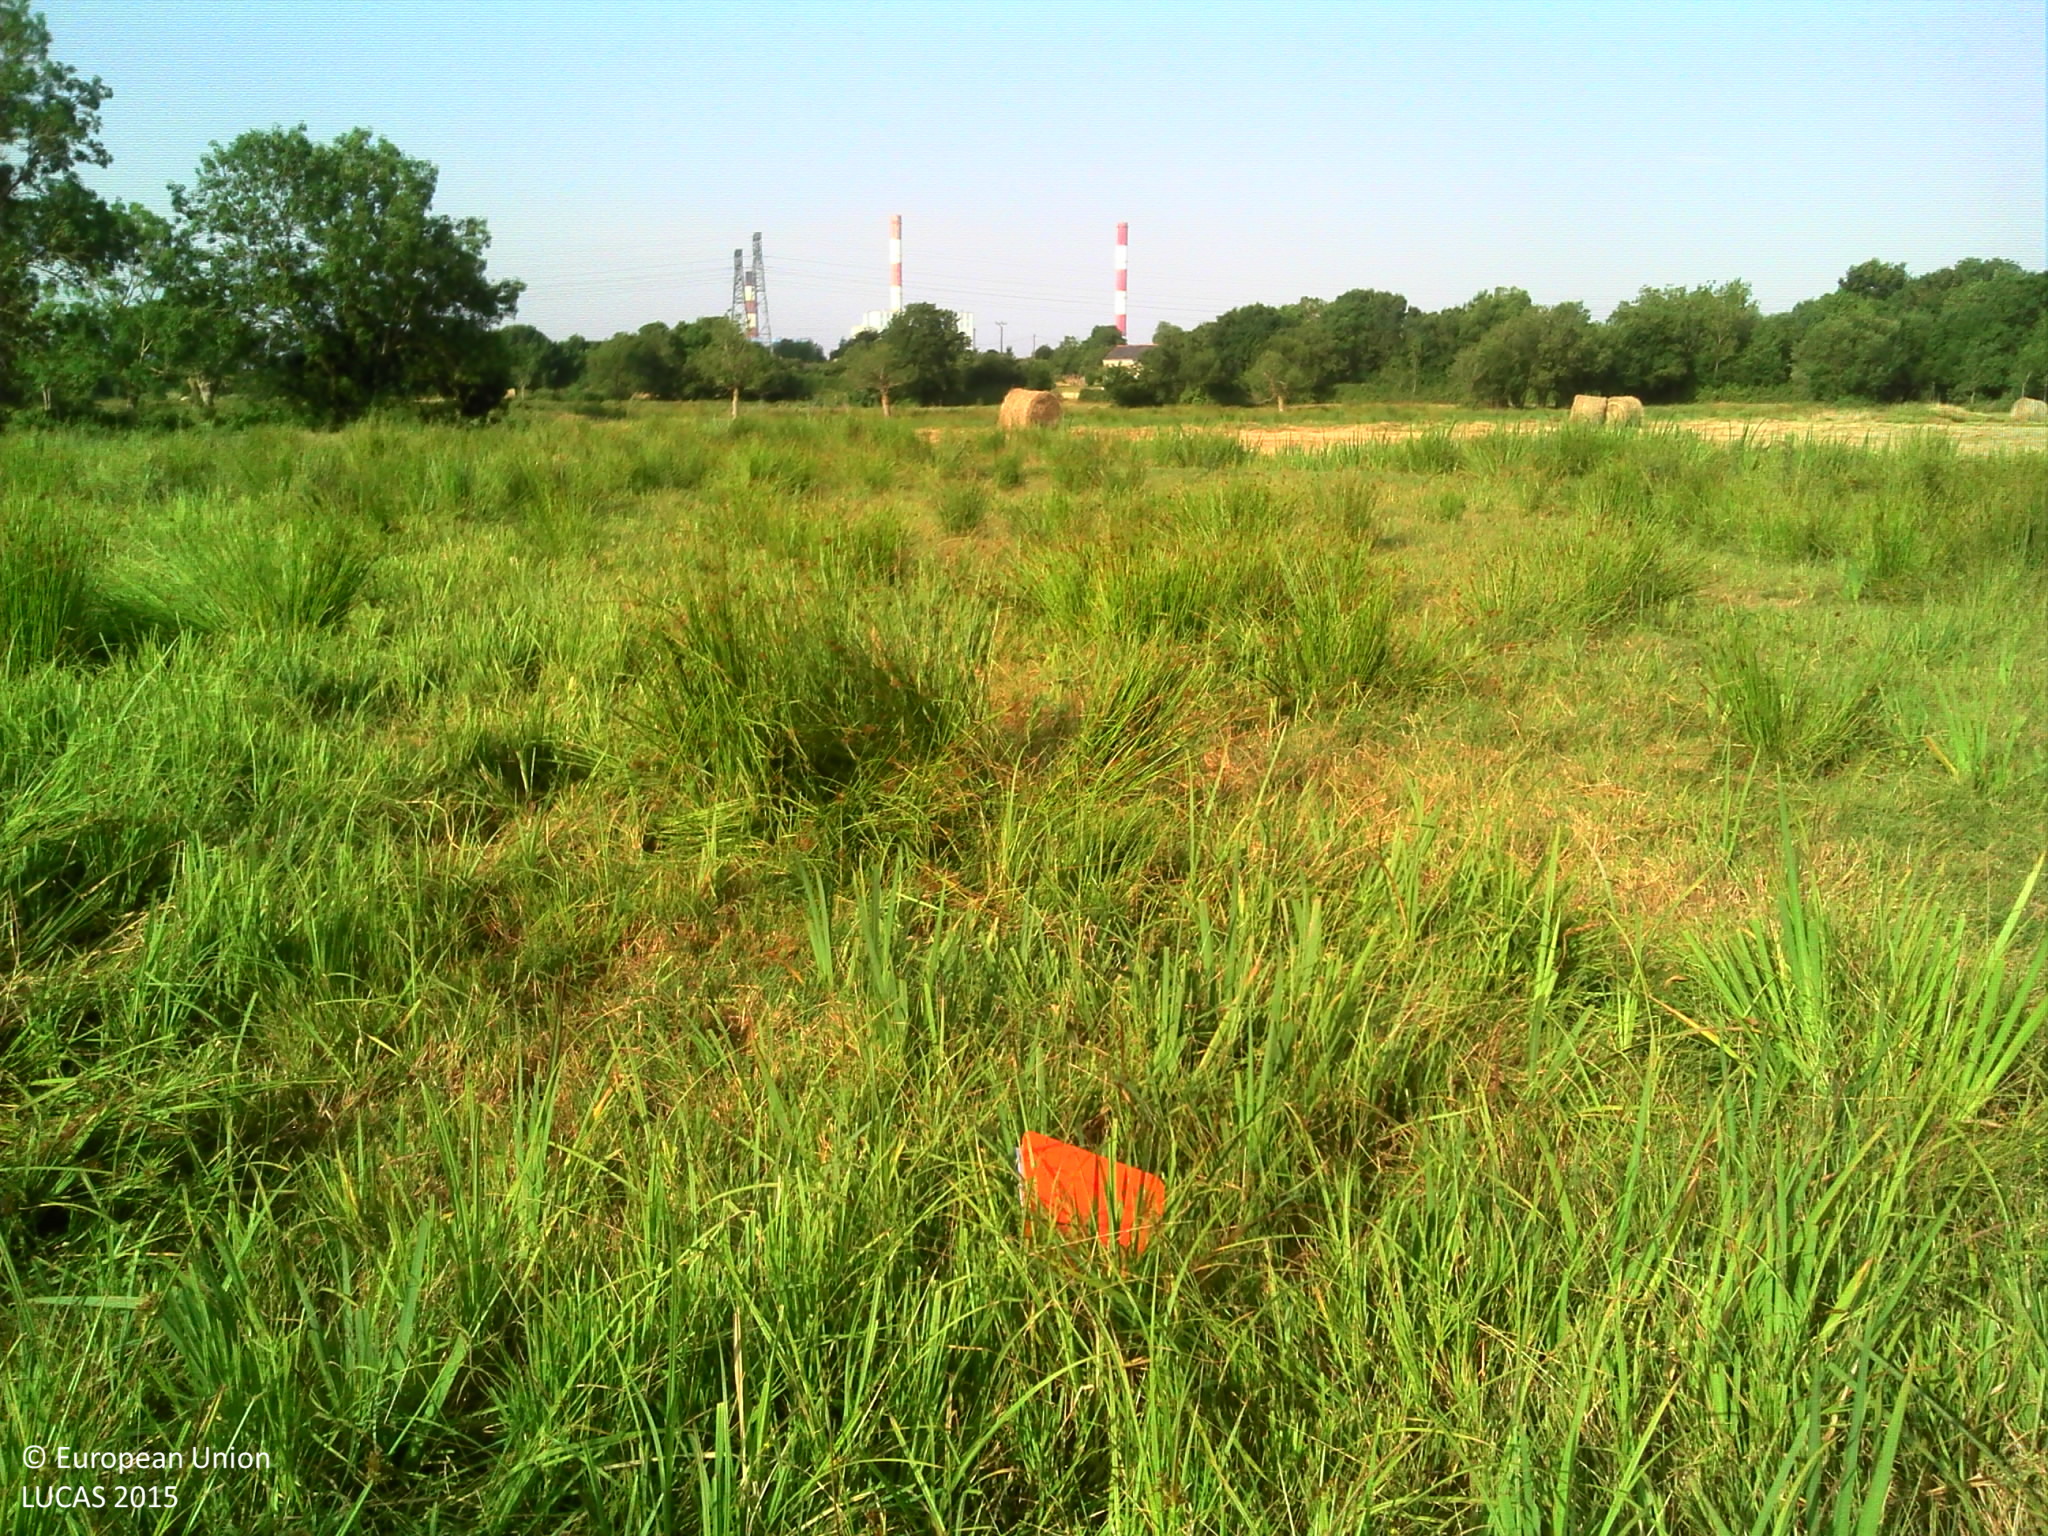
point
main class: Grassland
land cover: Grassland without tree/shrub cover
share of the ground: > 75 %
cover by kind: herbaceous plants 100 %
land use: Agriculture (excluding fallow land and kitchen gardens)
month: July
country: FR
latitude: 47.2903
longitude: -1.8545
